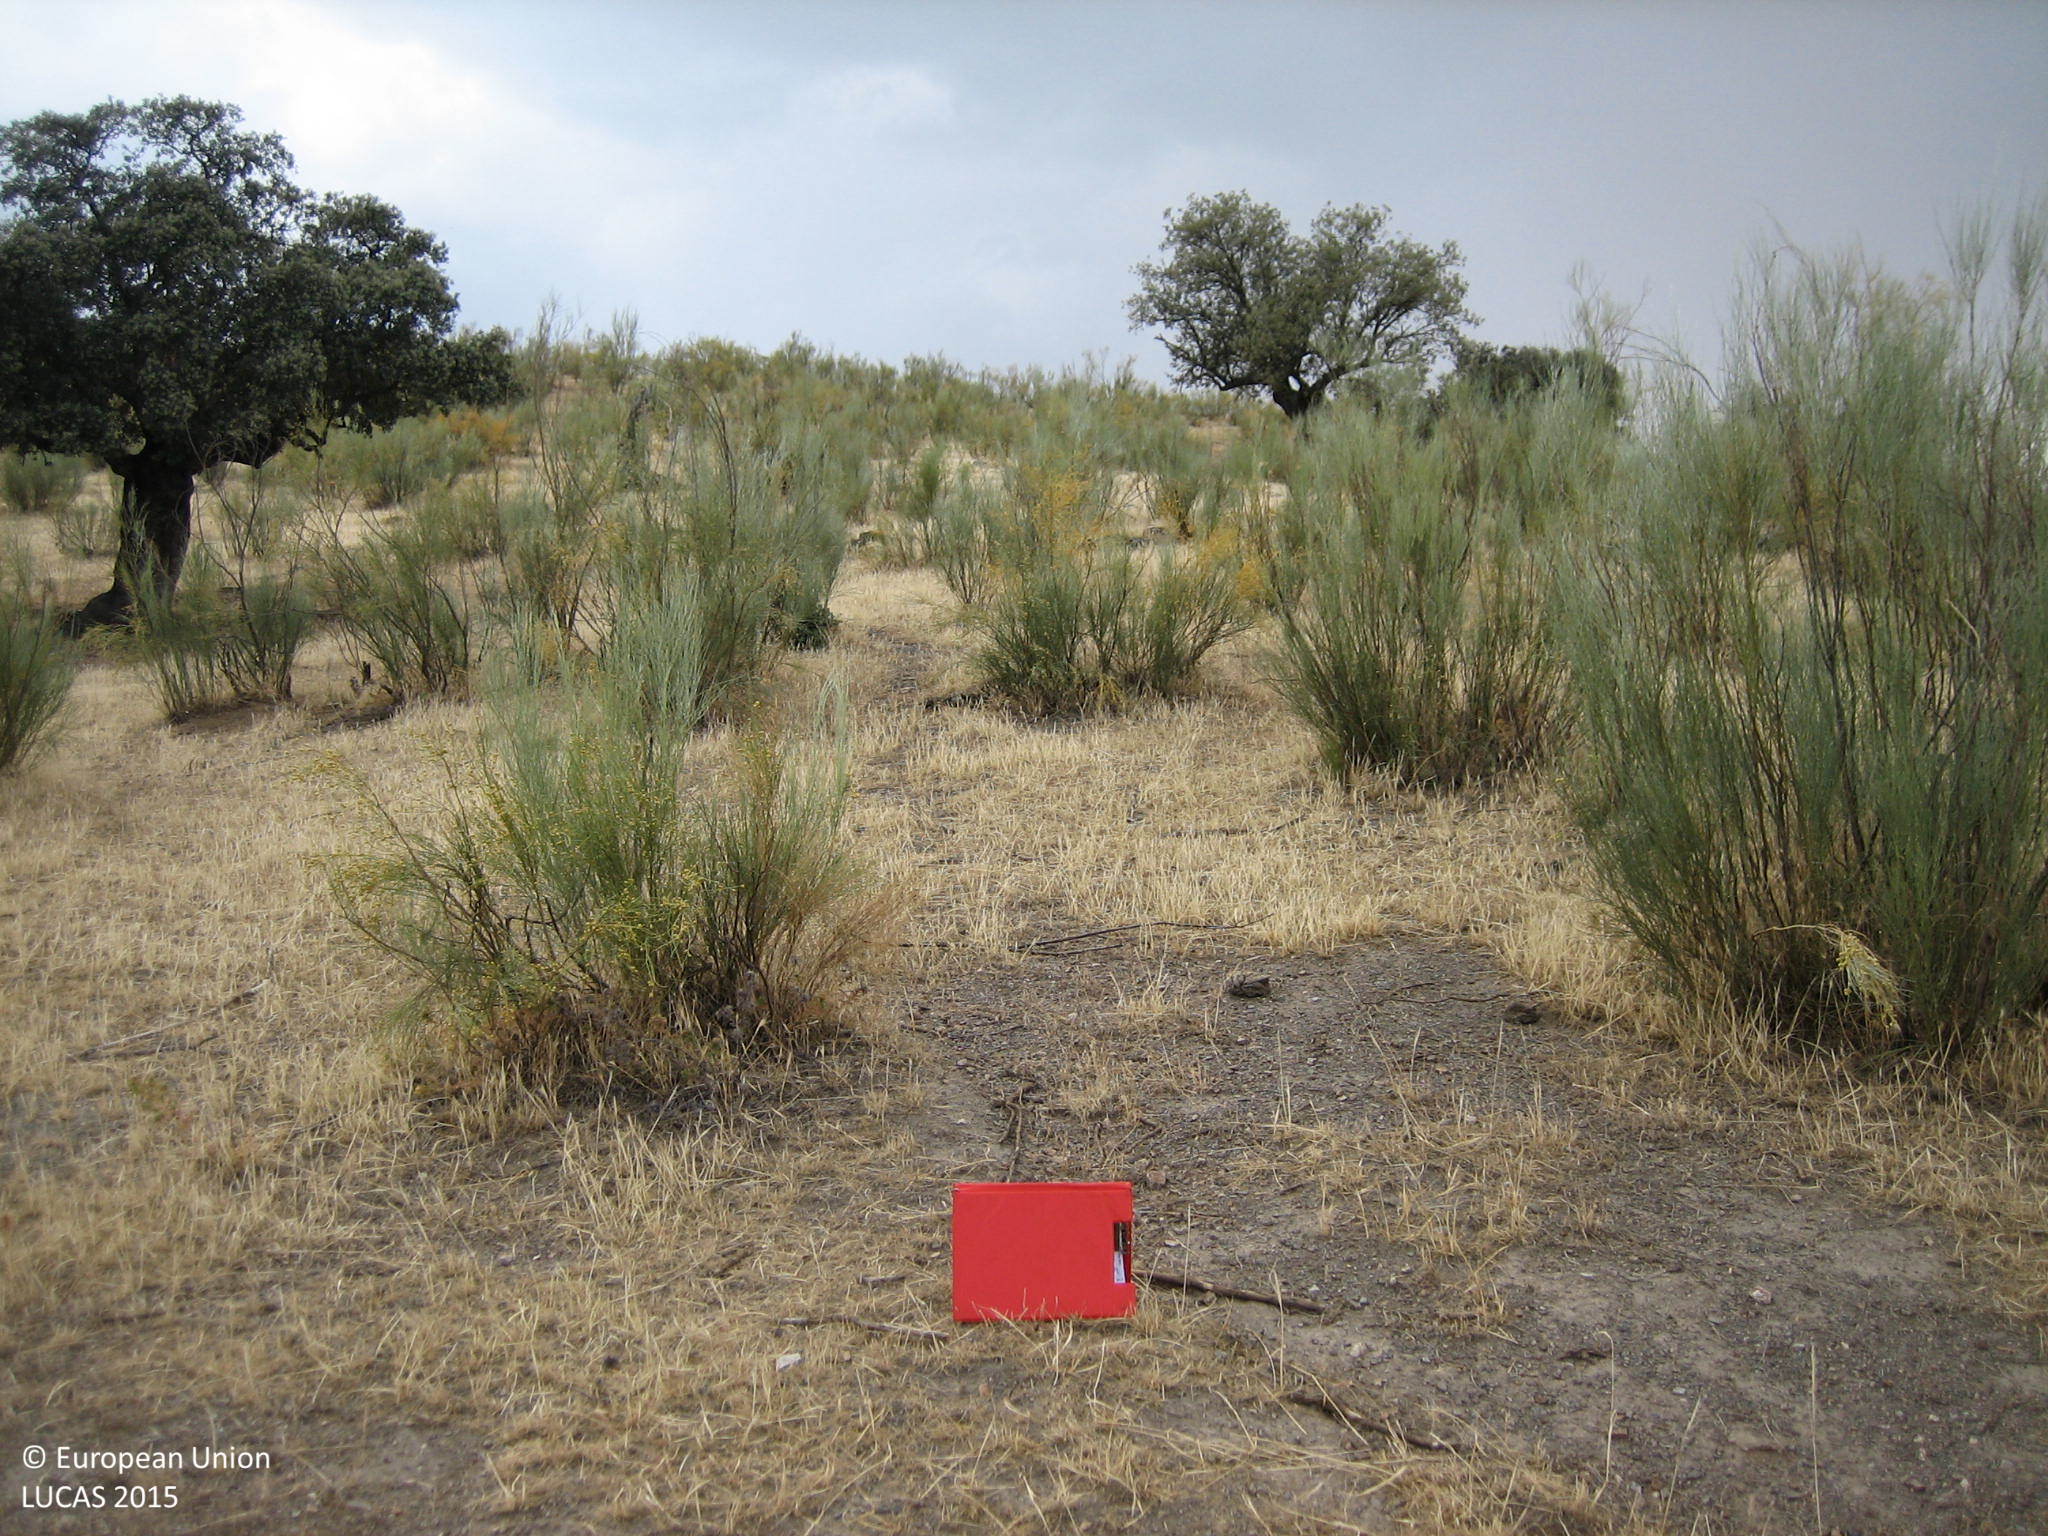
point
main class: Shrubland
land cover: Shrubland with sparse tree cover
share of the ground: 25 - 50 %
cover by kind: herbaceous plants 50 %, shrubs 30 %, unconsolidated bare surface 15 %, broadleaved forest trees 5 %
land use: Agriculture (excluding fallow land and kitchen gardens)
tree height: > 5 m
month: July
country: ES
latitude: 38.5721
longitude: -5.3572
